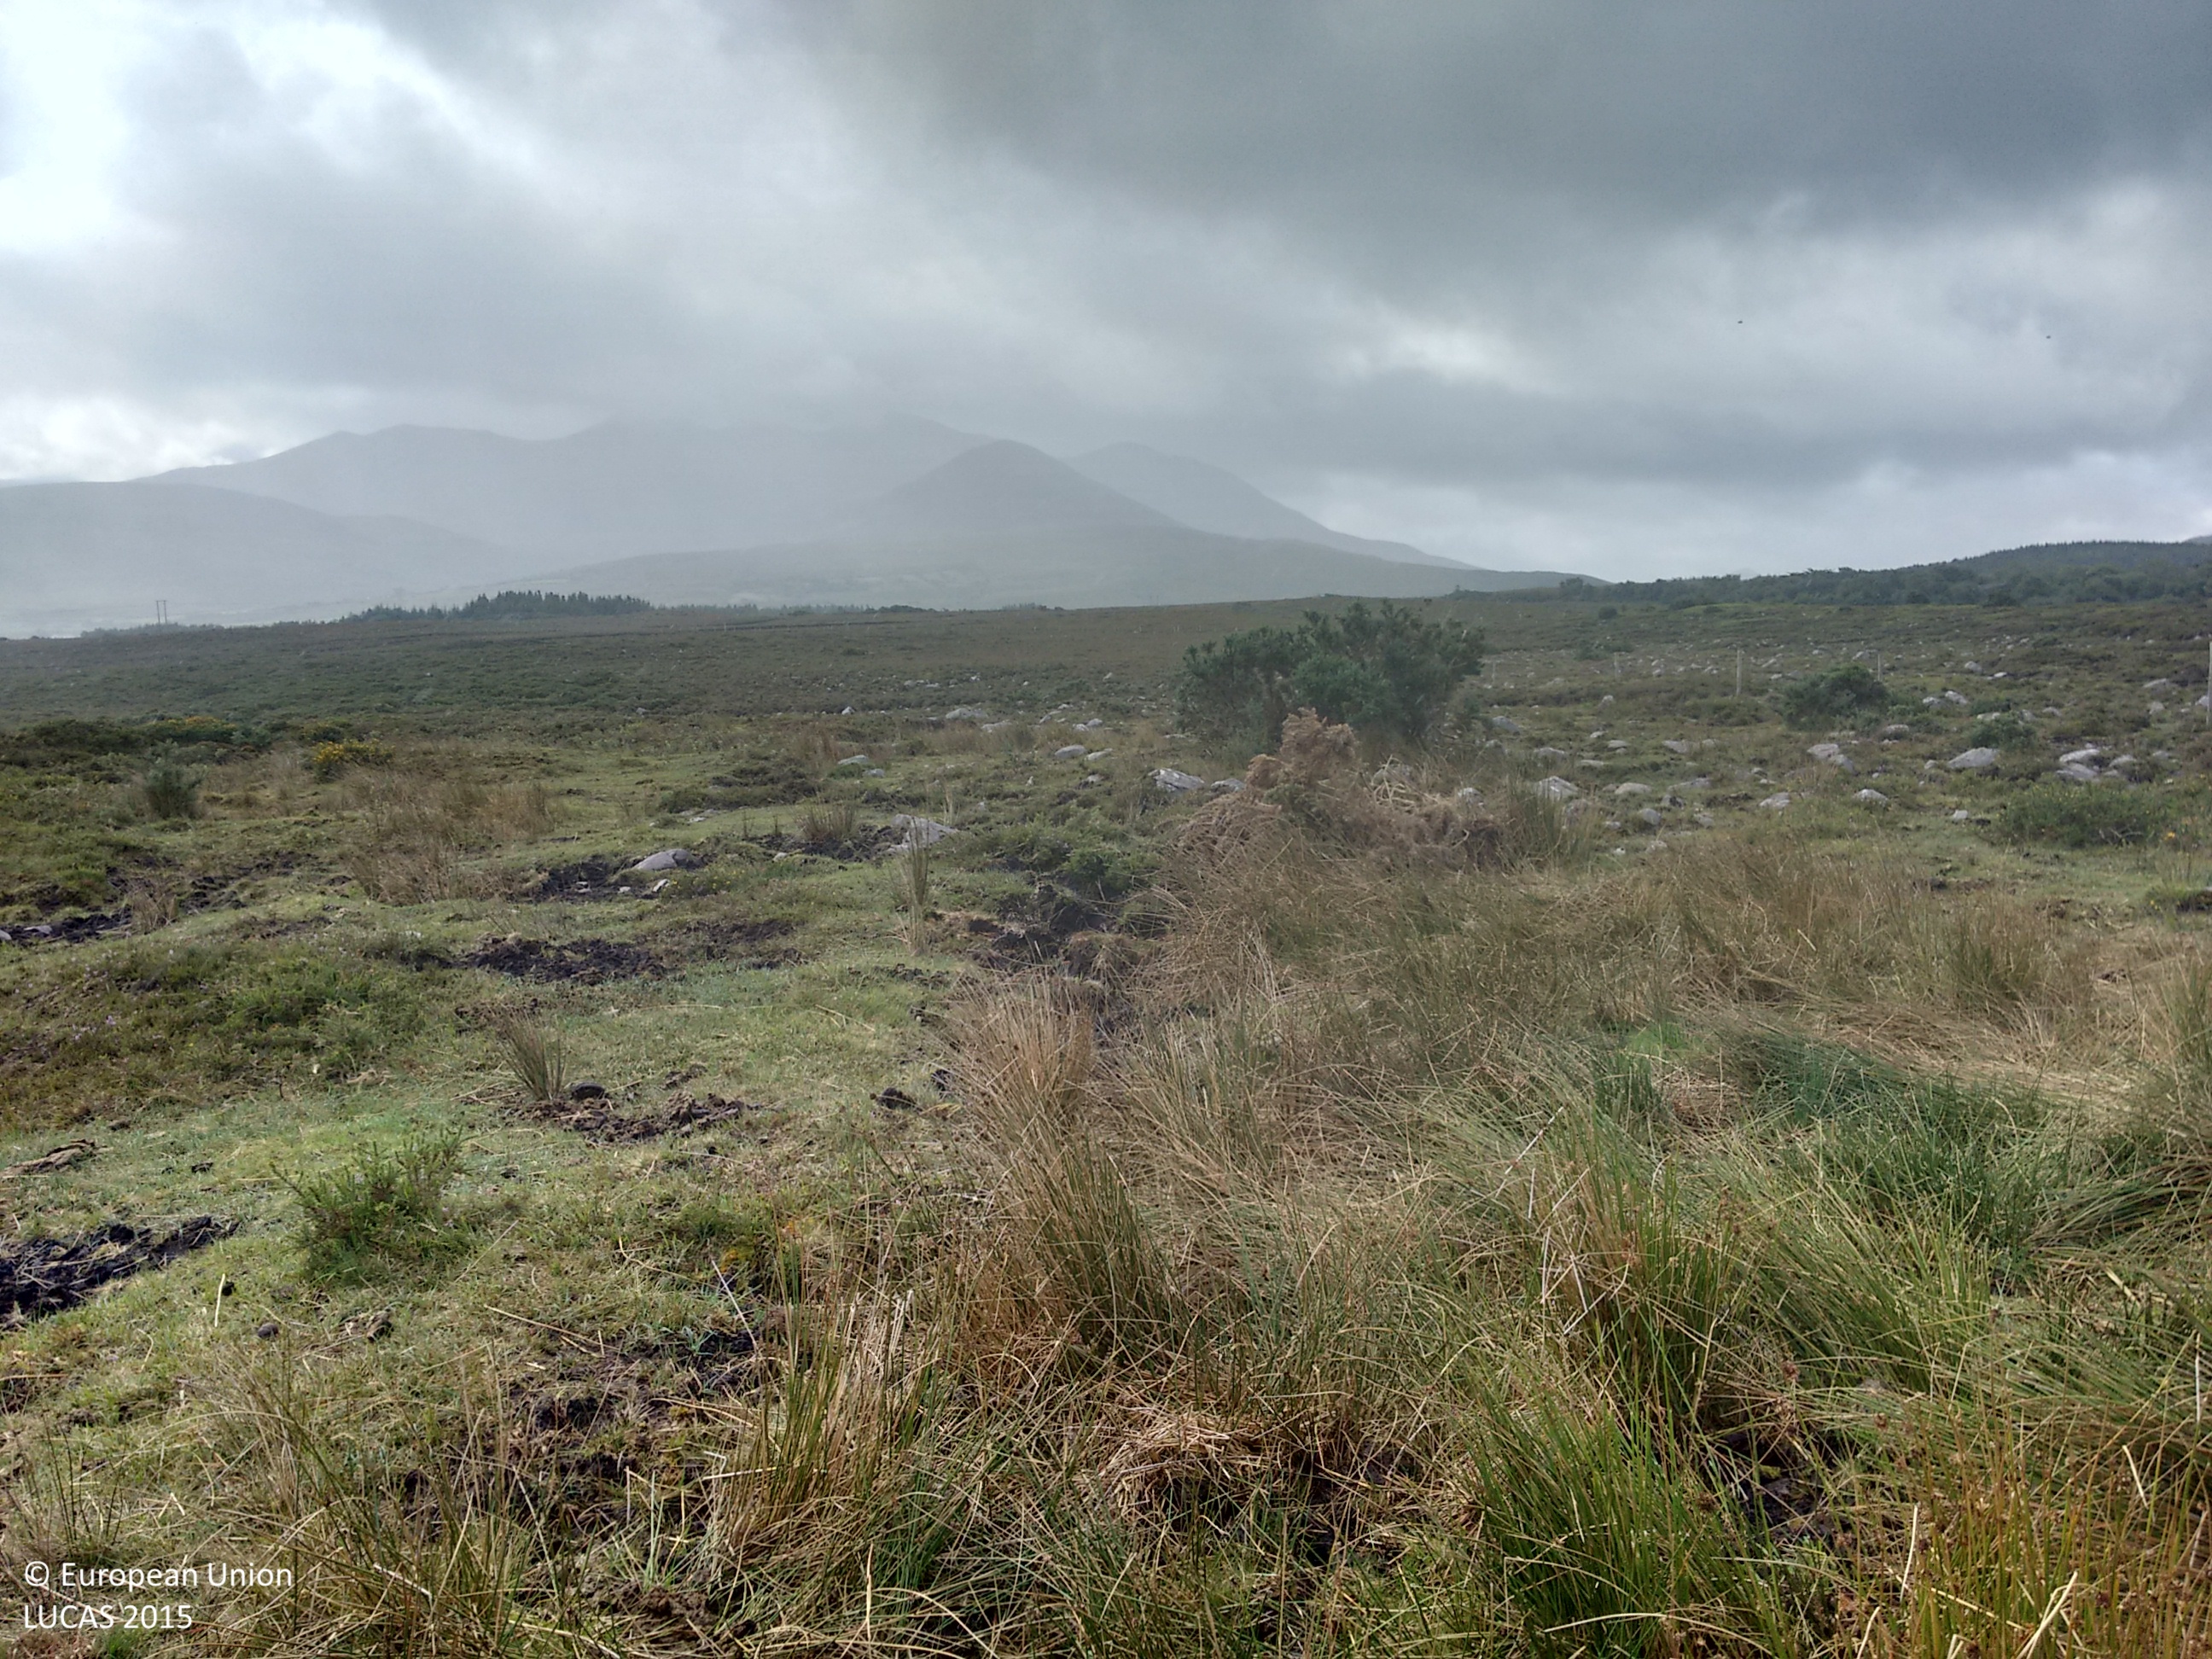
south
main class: Grassland
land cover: Grassland with sparse tree/shrub cover
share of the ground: > 75 %
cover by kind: herbaceous plants 85 %, shrubs 10 %, broadleaved forest trees 5 %
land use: Agriculture (excluding fallow land and kitchen gardens)
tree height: < 5 m
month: August
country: IE
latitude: 52.0610
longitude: -9.7747
